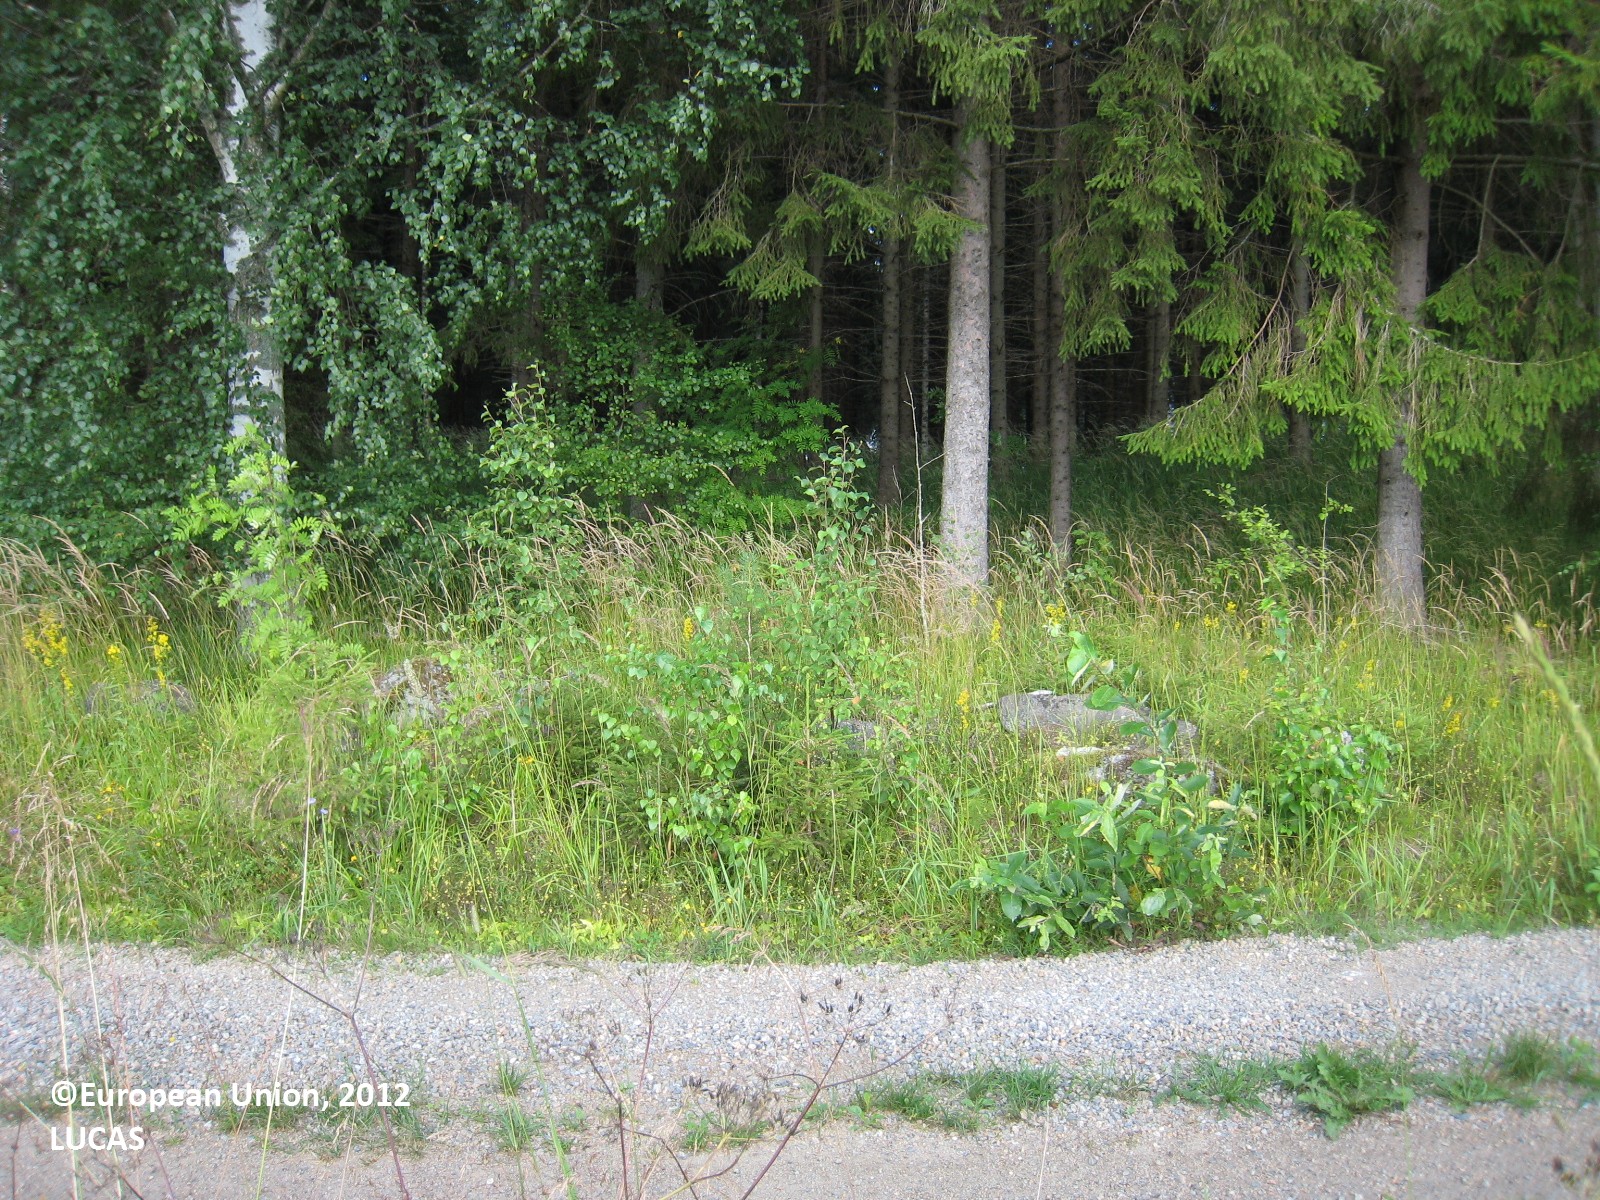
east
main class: Cropland
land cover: Oats
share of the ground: 50 - 75 %
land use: Agriculture (excluding fallow land and kitchen gardens)
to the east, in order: Oats; Shruby margins; Tracks; Grassland with sparse tree/shrub cover; Spruce dominated coniferous woodland; Spruce dominated mixed woodland; Spruce dominated coniferous woodland; Spruce dominated mixed woodland; Broadleaved woodland; Ditches and canals; Grassland without tree/shrub cover; Temporary grasslands
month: July
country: FI
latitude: 61.6720
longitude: 26.0201
